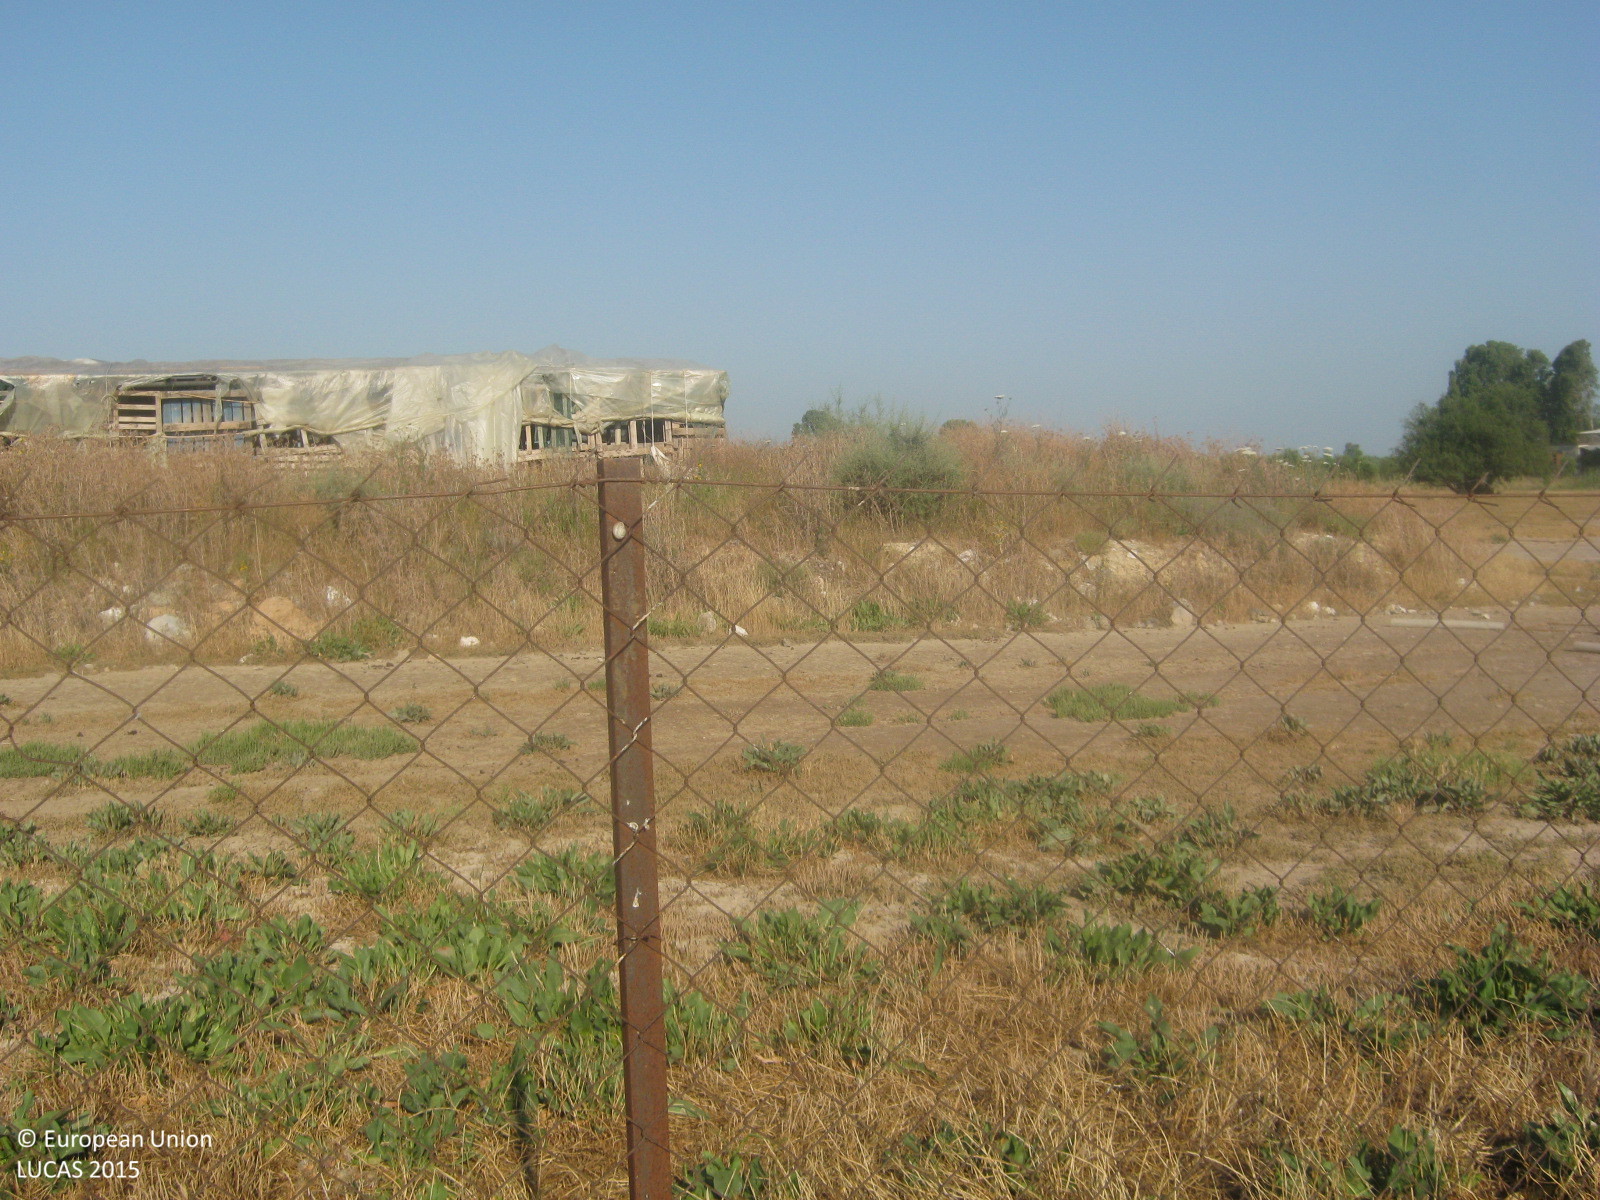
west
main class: Grassland
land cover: Spontaneously vegetated surfaces
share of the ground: 50 - 75 %
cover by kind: herbaceous plants 60 %, unconsolidated bare surface 35 %, shrubs 5 %
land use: Semi-natural and natural areas not in use
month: June
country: GR
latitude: 38.3897
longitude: 21.2896
